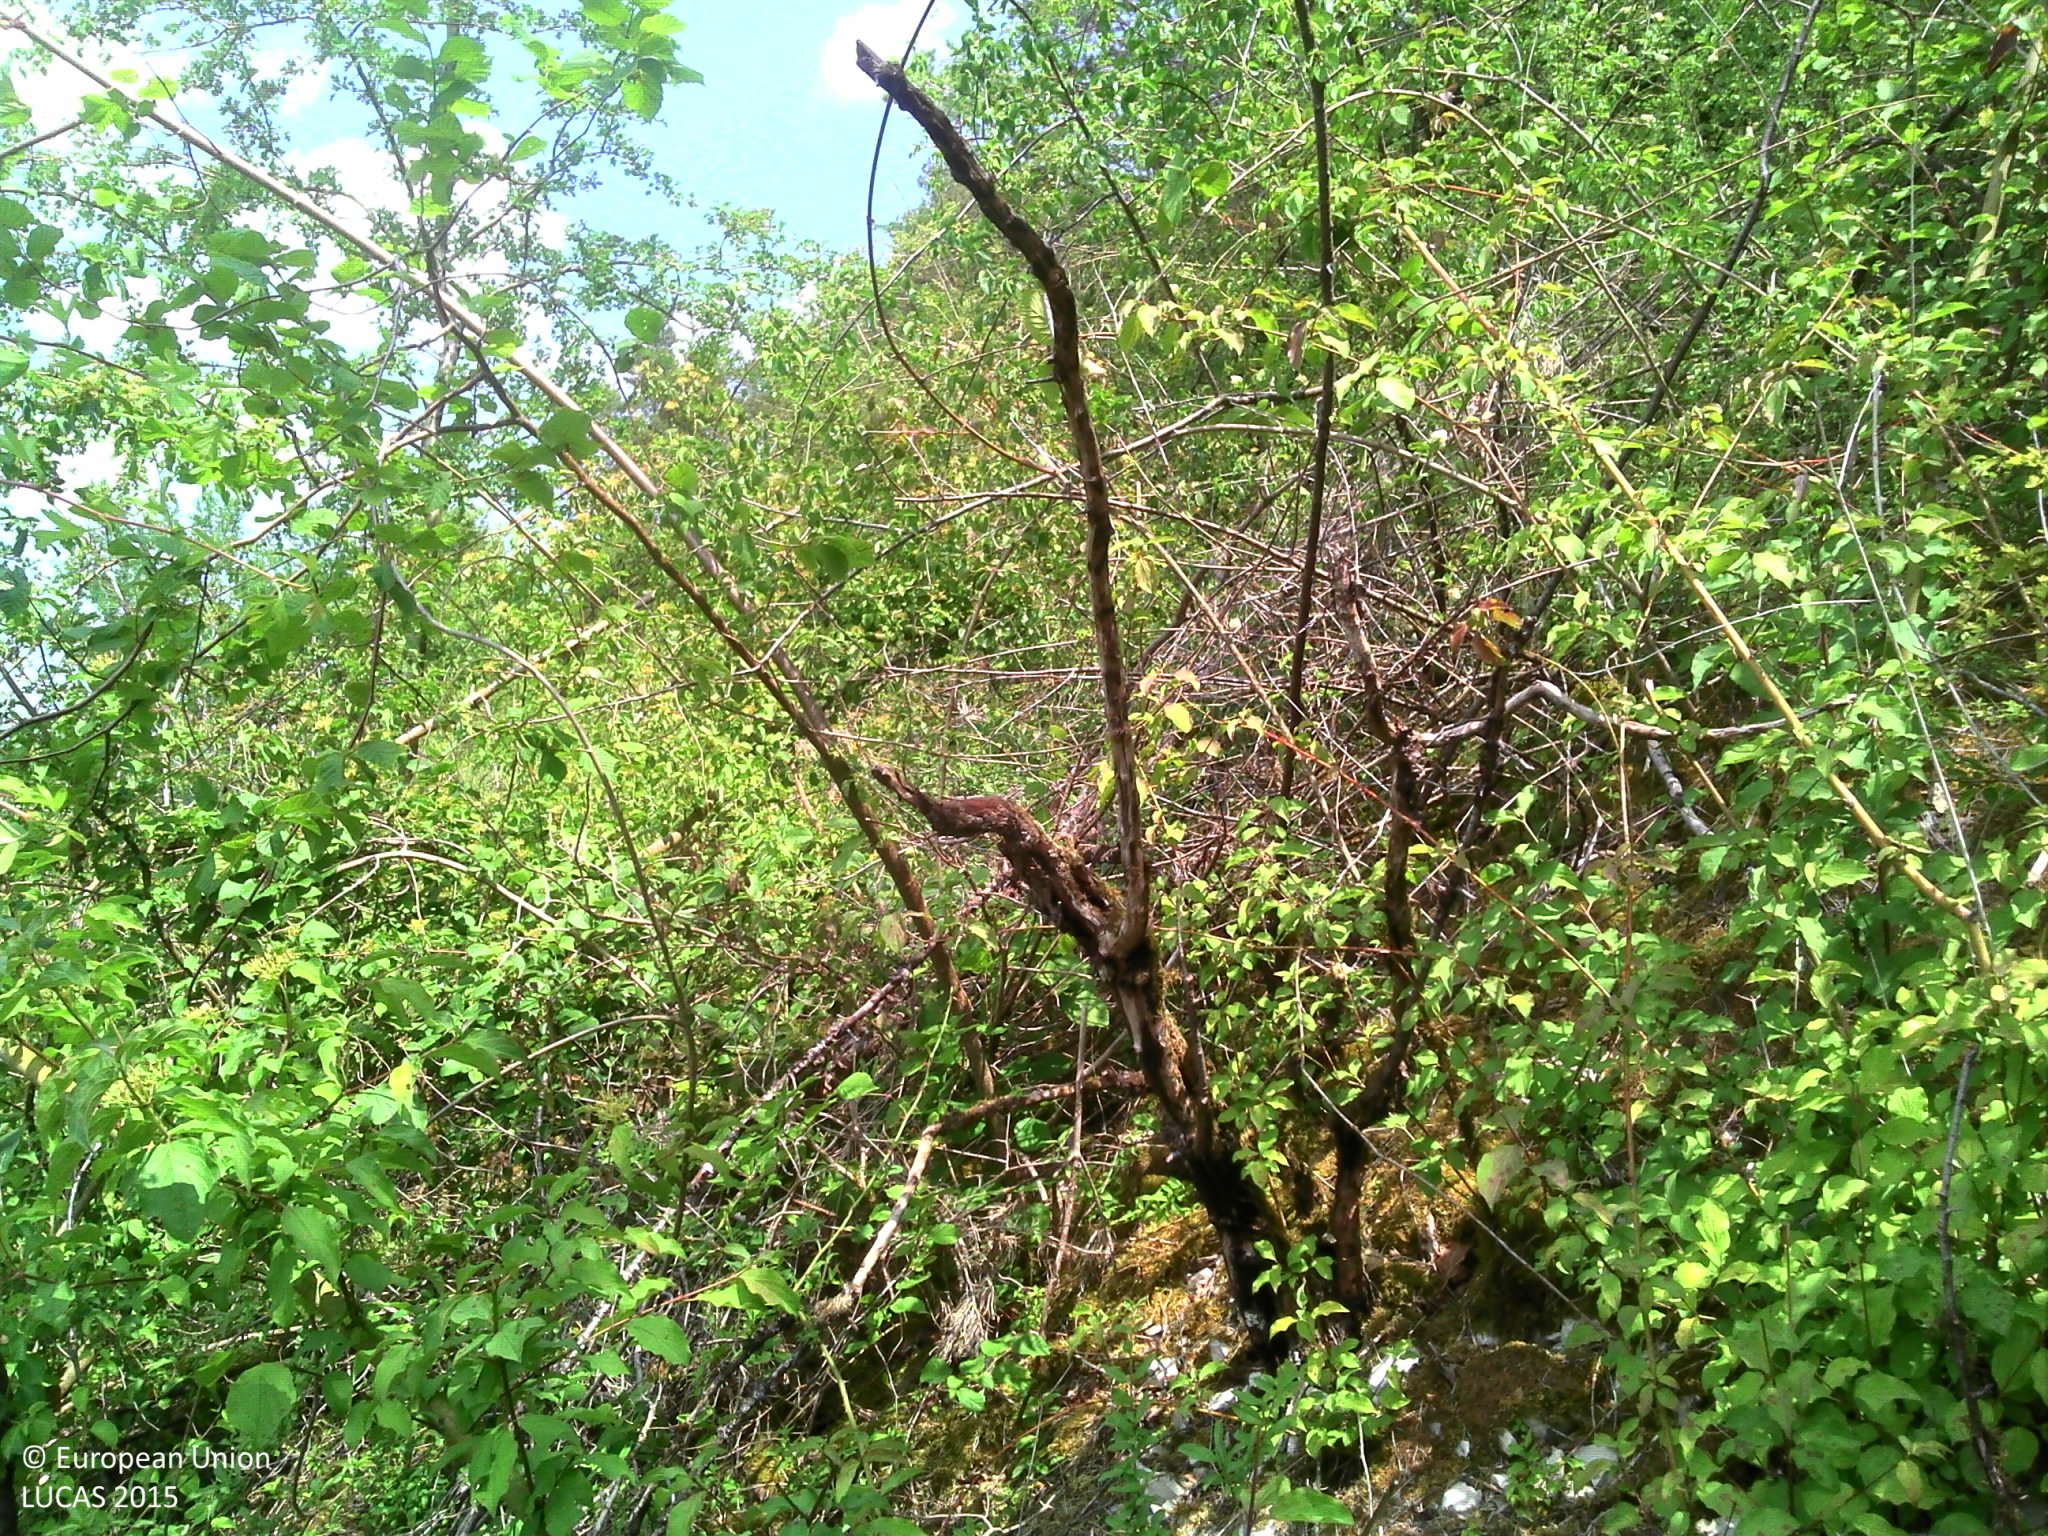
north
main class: Woodland
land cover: Broadleaved woodland
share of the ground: > 75 %
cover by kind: broadleaved forest trees 80 %, coniferous forest trees 10 %, herbaceous plants 5 %, lichens and mosses 5 %
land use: Forestry
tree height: < 5 m
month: June
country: FR
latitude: 48.4064
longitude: 5.1762
